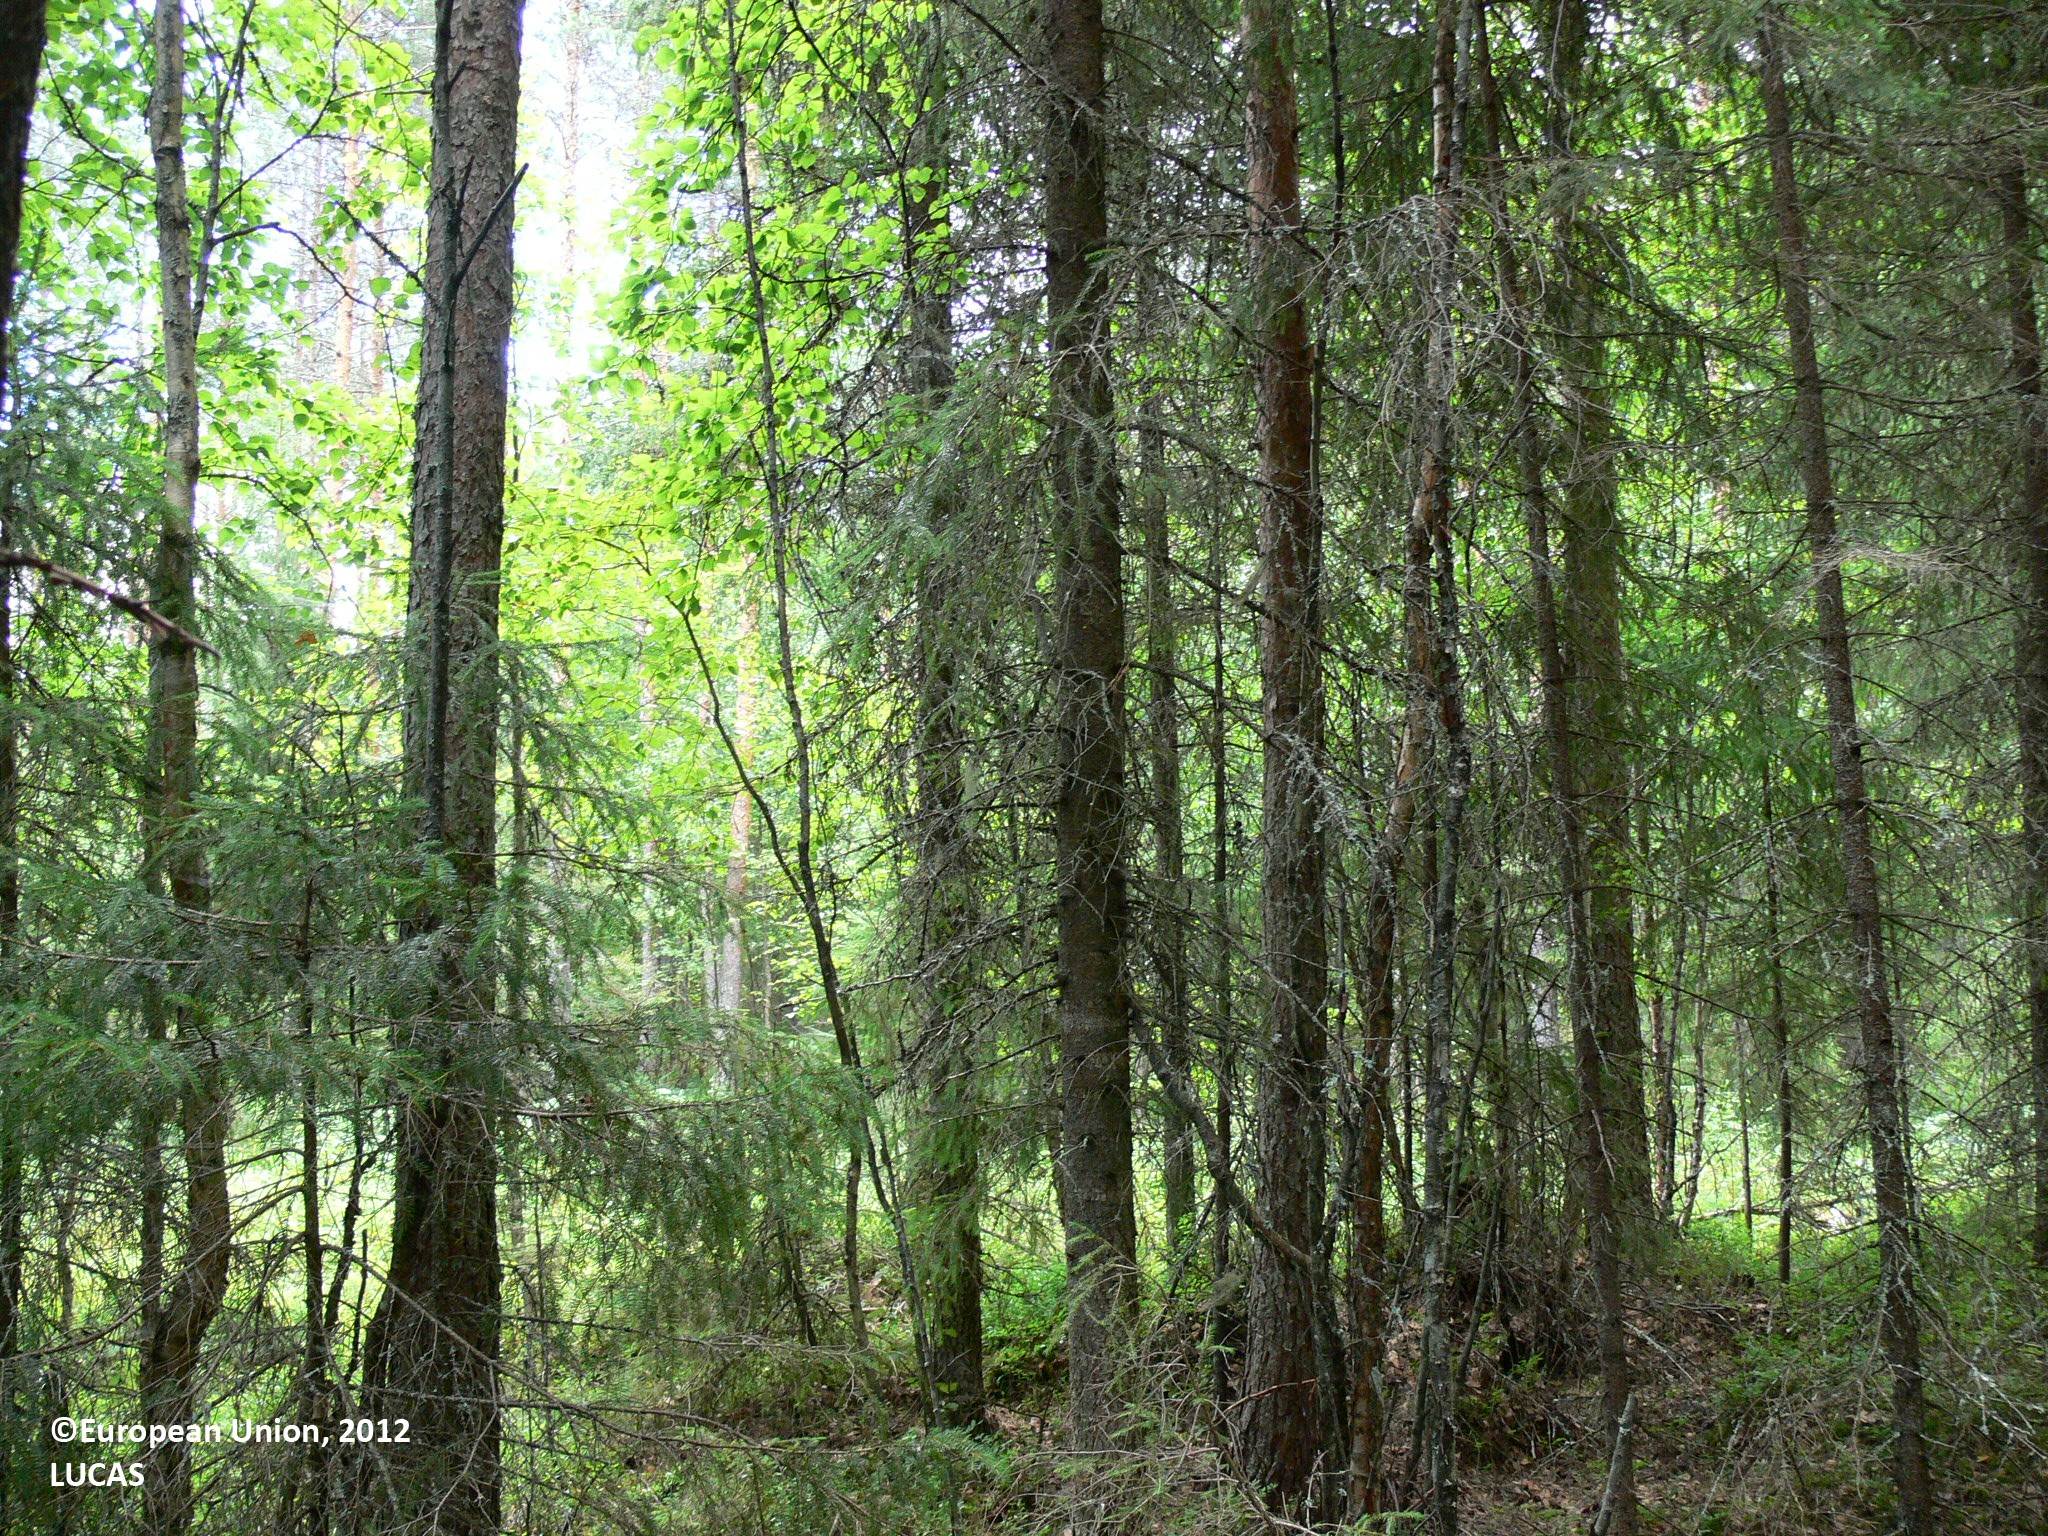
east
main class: Woodland
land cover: Other coniferous woodland
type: boreal forest
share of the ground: > 75 %
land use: Forestry
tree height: > 5 m
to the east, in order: Other coniferous woodland; Ditches and canals; Other coniferous woodland; Ditches and canals; Other coniferous woodland; Pine dominated coniferous woodland; Ditches and canals; Other coniferous woodland; Ditches and canals; Other coniferous woodland
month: August
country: FI
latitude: 62.0420
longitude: 29.3791
